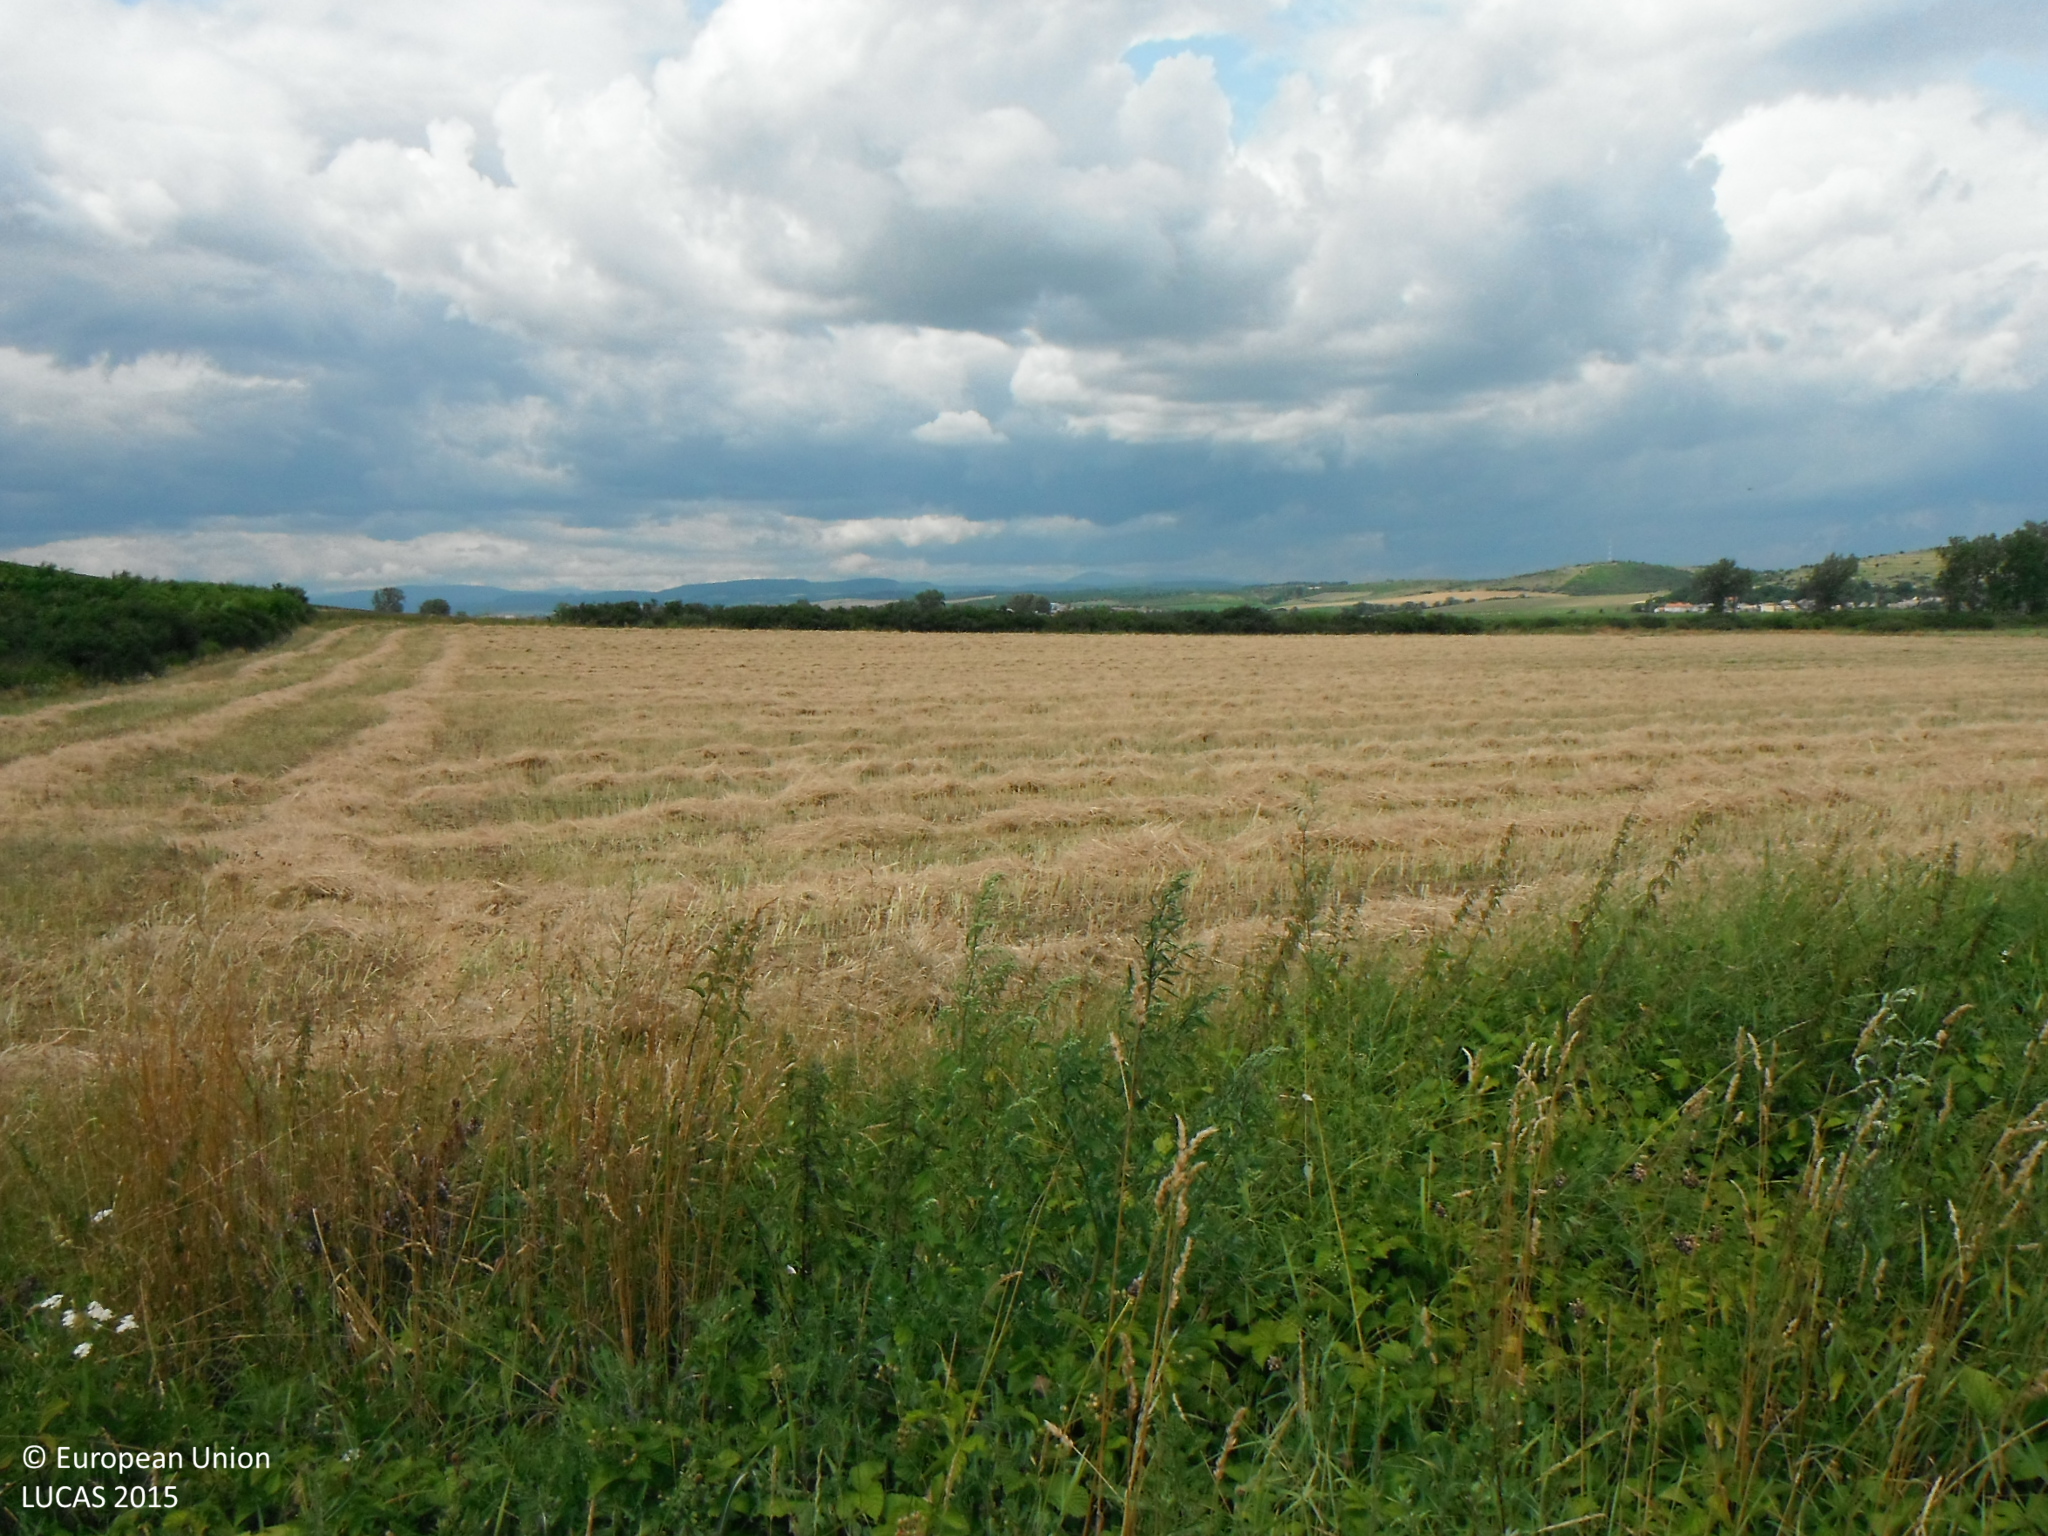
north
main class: Grassland
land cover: Spontaneously vegetated surfaces
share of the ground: > 75 %
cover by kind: herbaceous plants 100 %
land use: Semi-natural and natural areas not in use
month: July
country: SK
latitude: 48.3484
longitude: 20.1917
